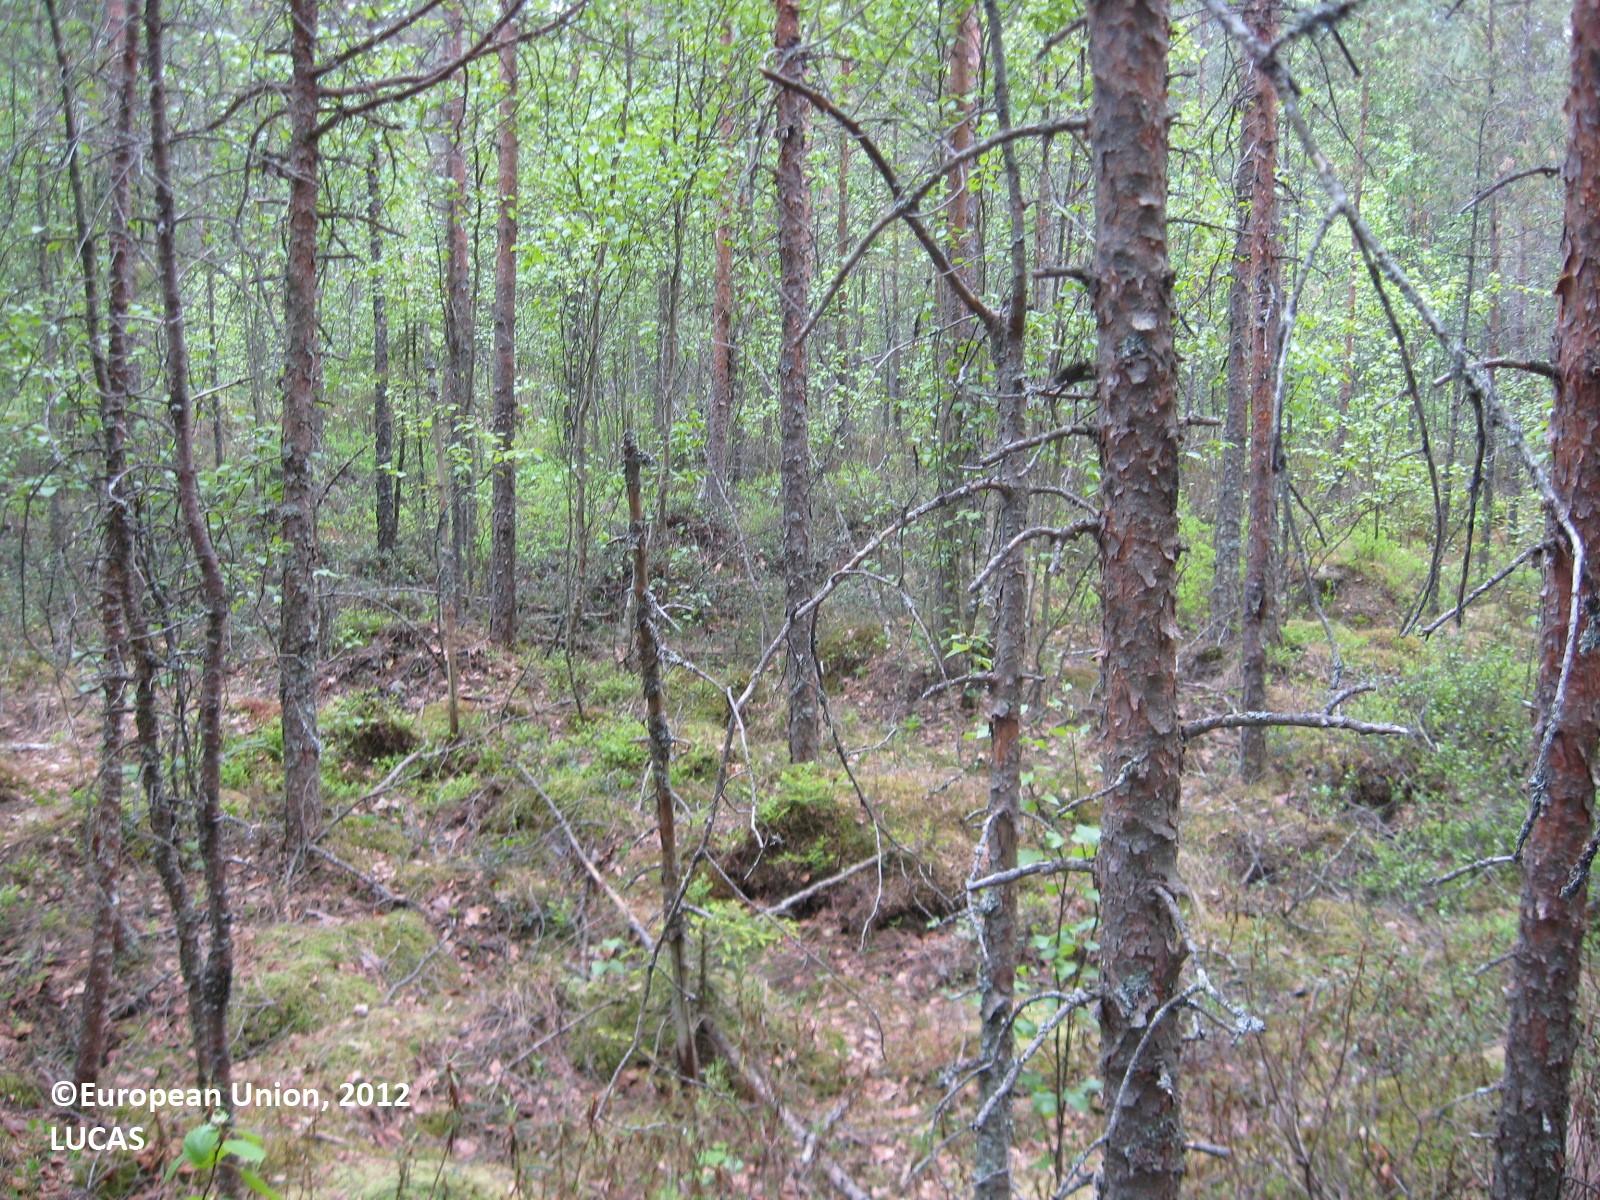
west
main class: Woodland
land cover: Pine dominated mixed woodland
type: boreal forest
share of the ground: > 75 %
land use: Forestry
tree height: > 5 m
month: June
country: FI
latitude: 63.1672
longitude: 22.7423
